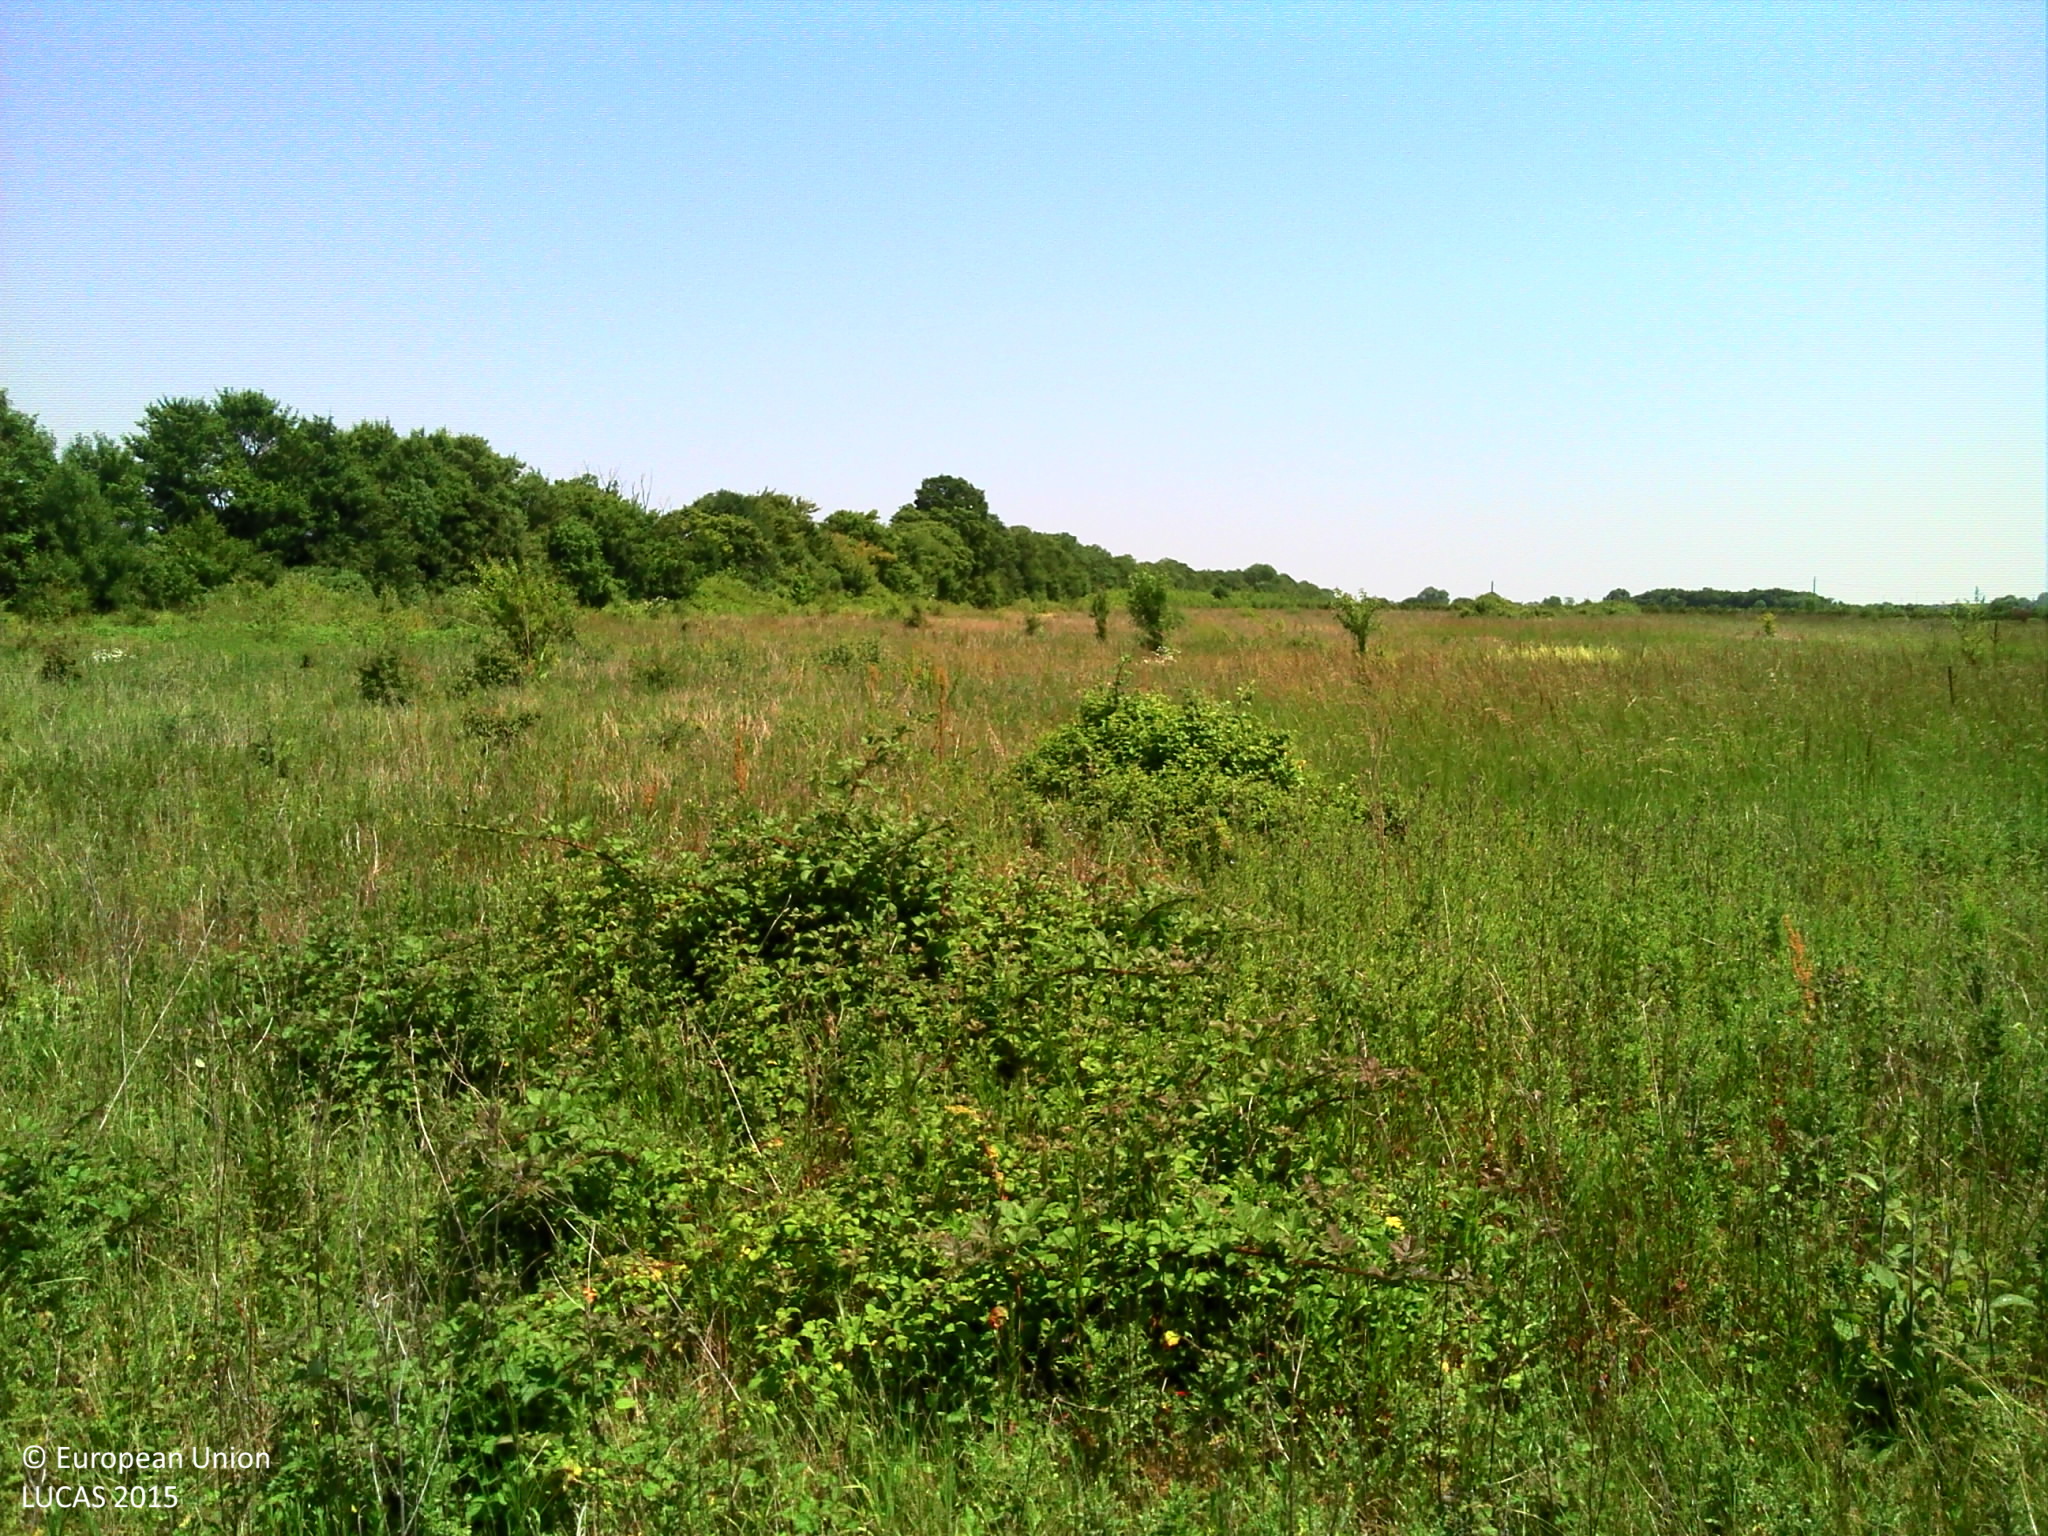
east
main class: Grassland
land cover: Grassland without tree/shrub cover
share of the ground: > 75 %
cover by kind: herbaceous plants 95 %, shrubs 5 %
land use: Agriculture (excluding fallow land and kitchen gardens)
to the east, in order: Grassland without tree/shrub cover; Abandoned hedges; Ditches and canals; Durum wheat
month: June
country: FR
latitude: 46.1518
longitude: -0.7613
